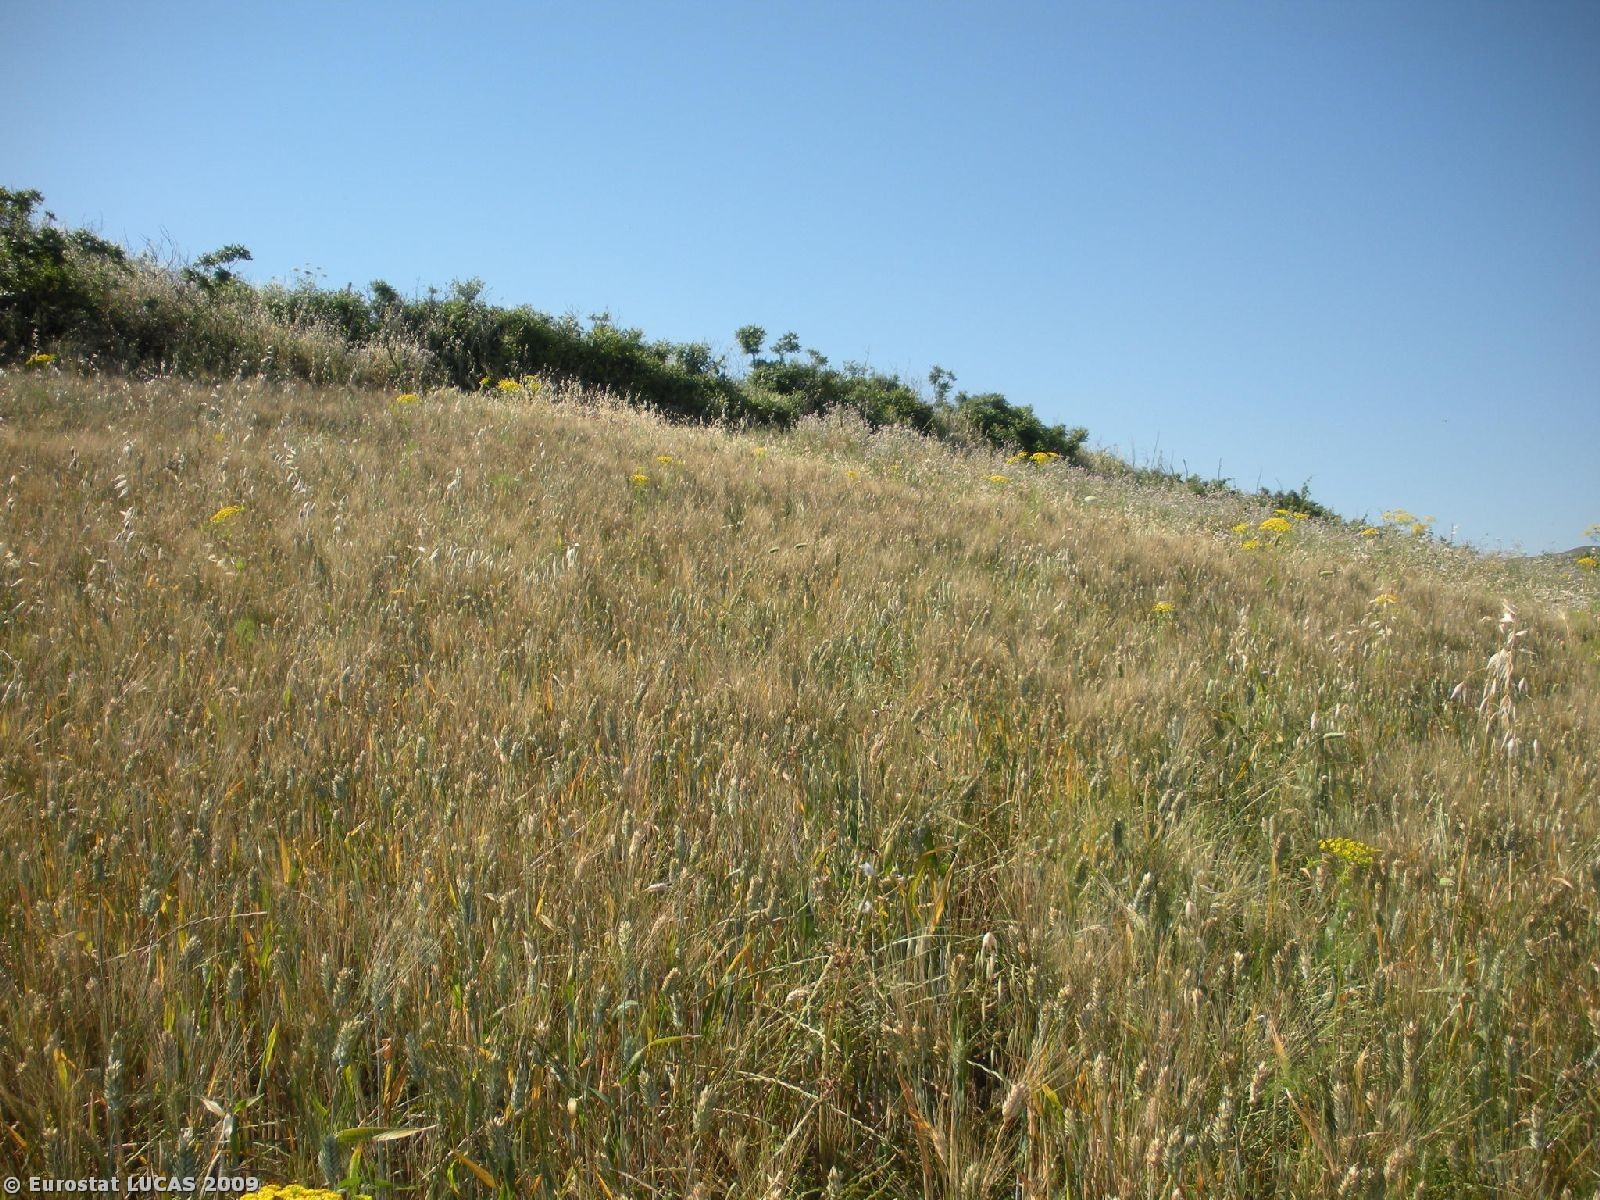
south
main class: Cropland
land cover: Durum wheat
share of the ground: > 75 %
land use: Agriculture (excluding fallow land and kitchen gardens)
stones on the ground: < 10 %
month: June
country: IT
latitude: 38.0229
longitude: 13.1331
